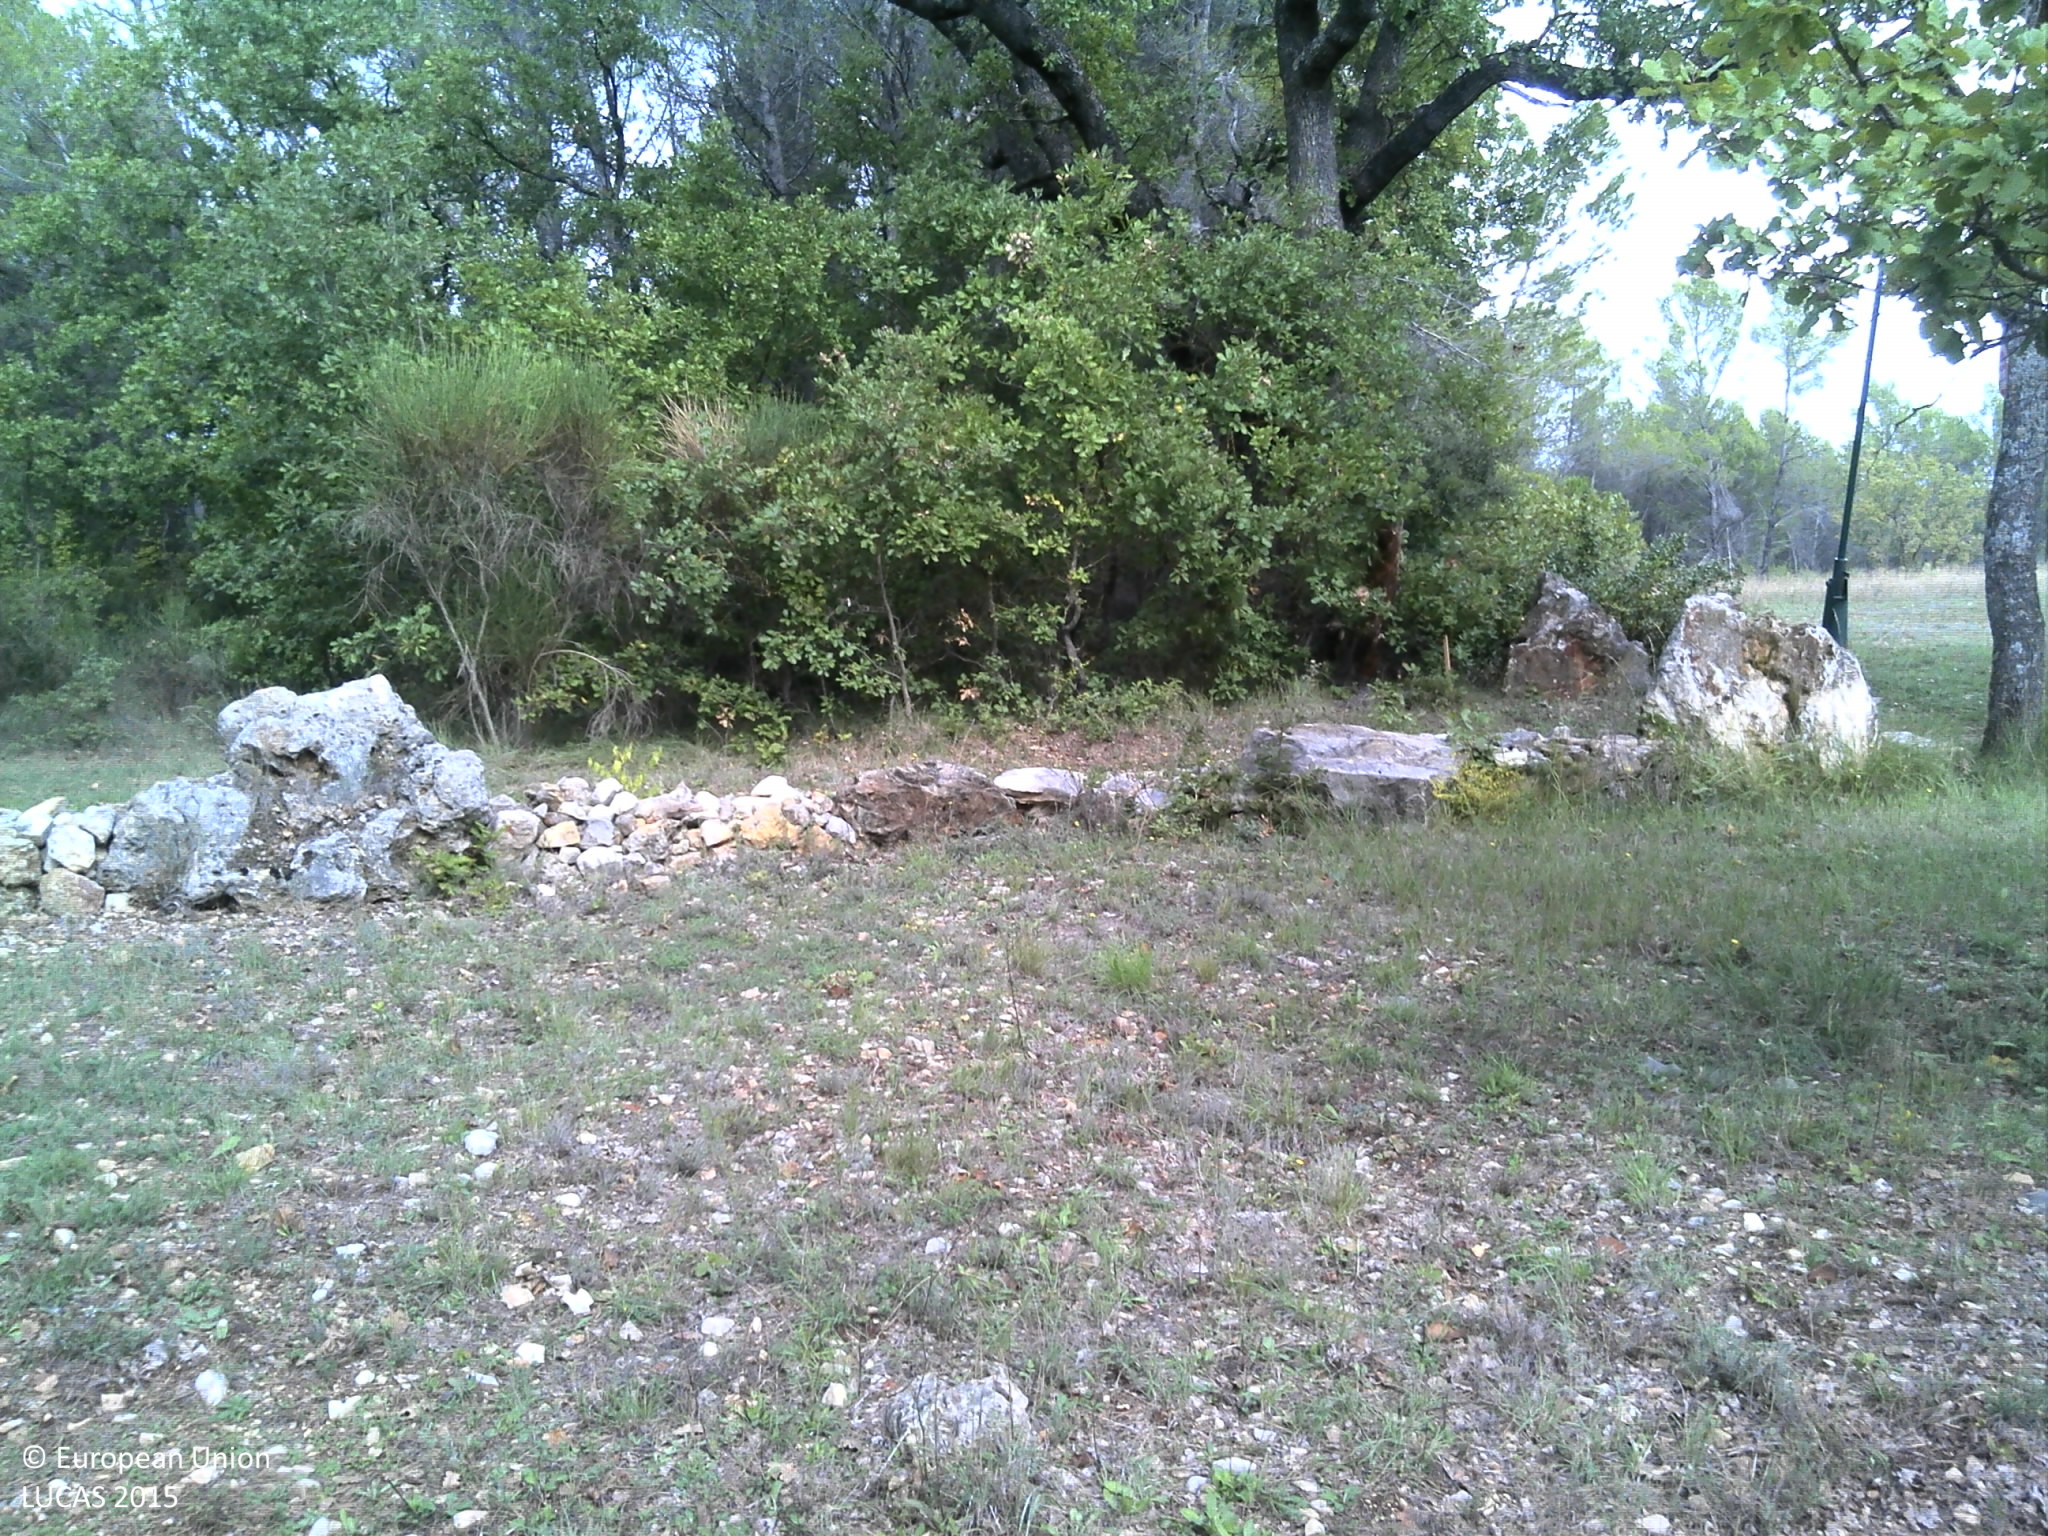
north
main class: Grassland
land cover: Grassland with sparse tree/shrub cover
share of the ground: > 75 %
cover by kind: herbaceous plants 55 %, unconsolidated bare surface 30 %, consolidated bare surface 10 %, broadleaved forest trees 5 %
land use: Residential
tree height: > 5 m
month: October
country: FR
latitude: 43.5522
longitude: 6.5301
